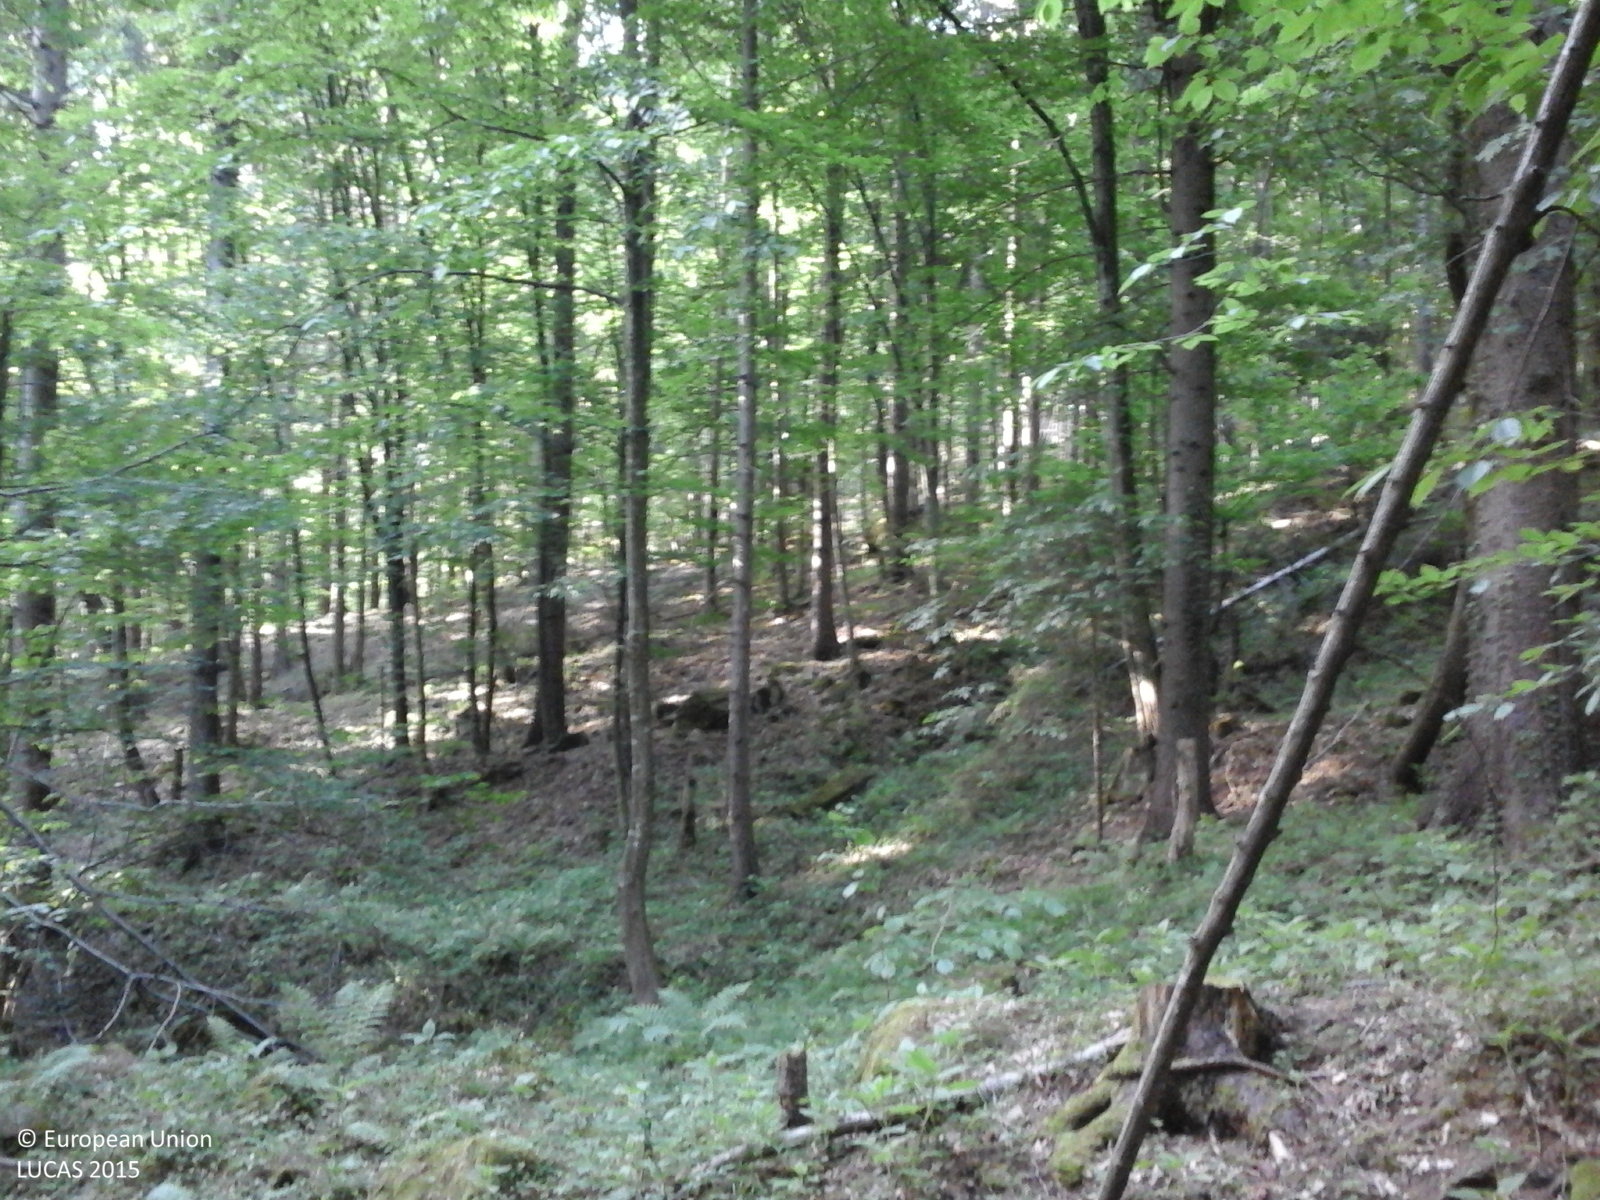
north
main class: Woodland
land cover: Spruce dominated mixed woodland
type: hemiboreal forest and nemoral coniferous forest and mixed broadleaved-coniferous forest
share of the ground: > 75 %
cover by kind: coniferous forest trees 60 %, broadleaved forest trees 40 %
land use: Forestry
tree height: > 5 m
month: May
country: RO
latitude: 45.2664
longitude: 25.8732
